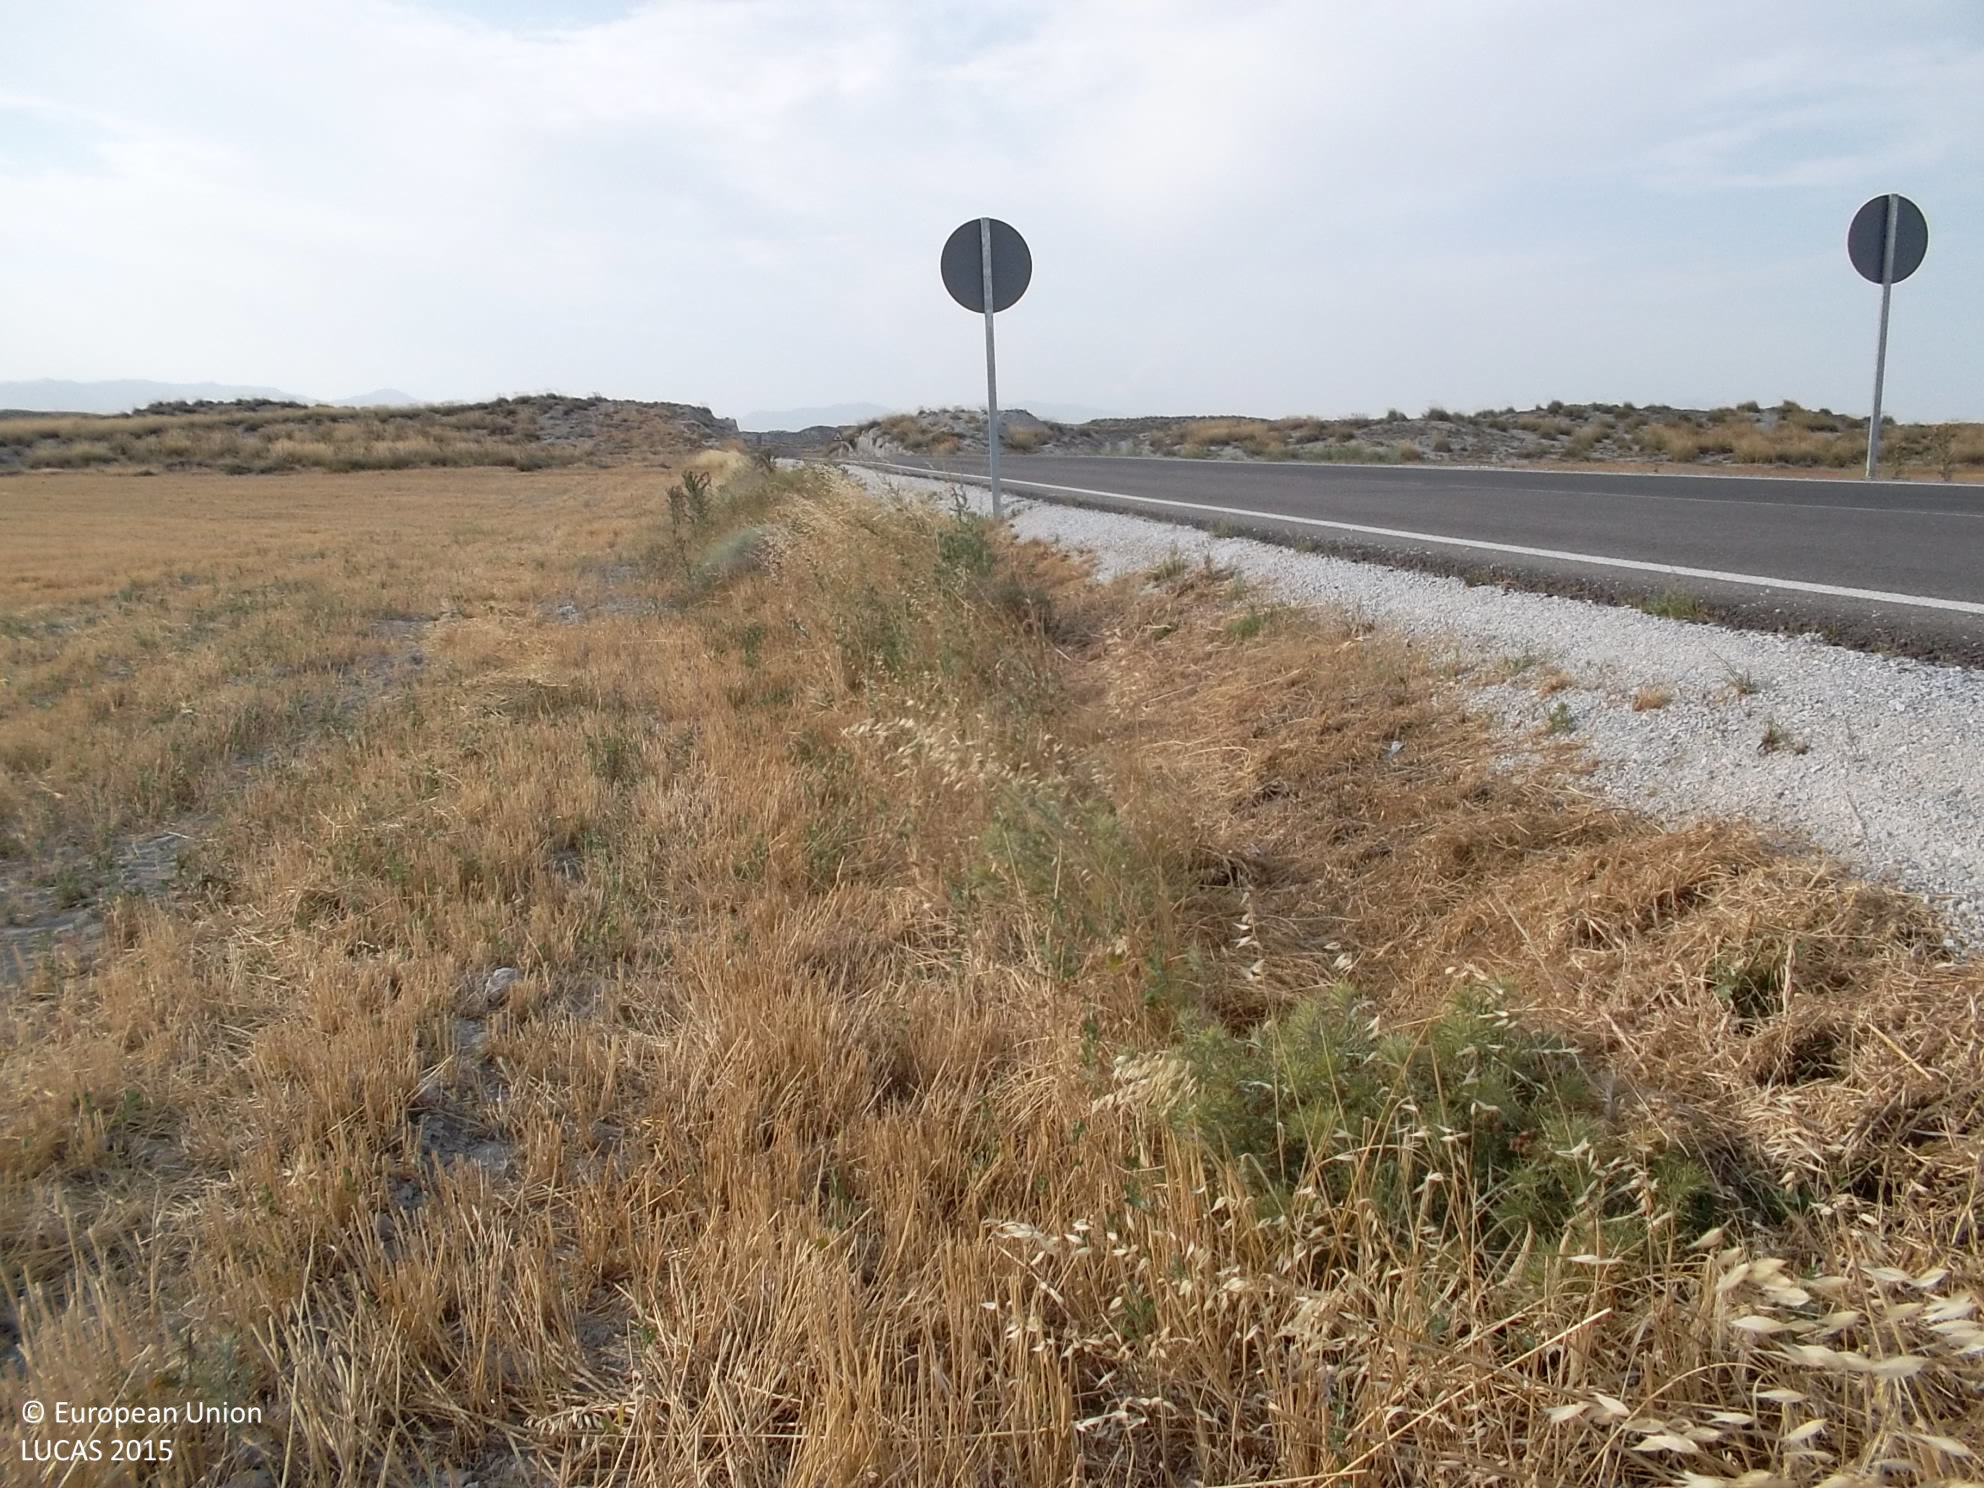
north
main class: Cropland
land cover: Barley
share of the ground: < 10 %
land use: Agriculture (excluding fallow land and kitchen gardens)
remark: Harvested field
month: July
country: ES
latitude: 37.6418
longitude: -2.7158
